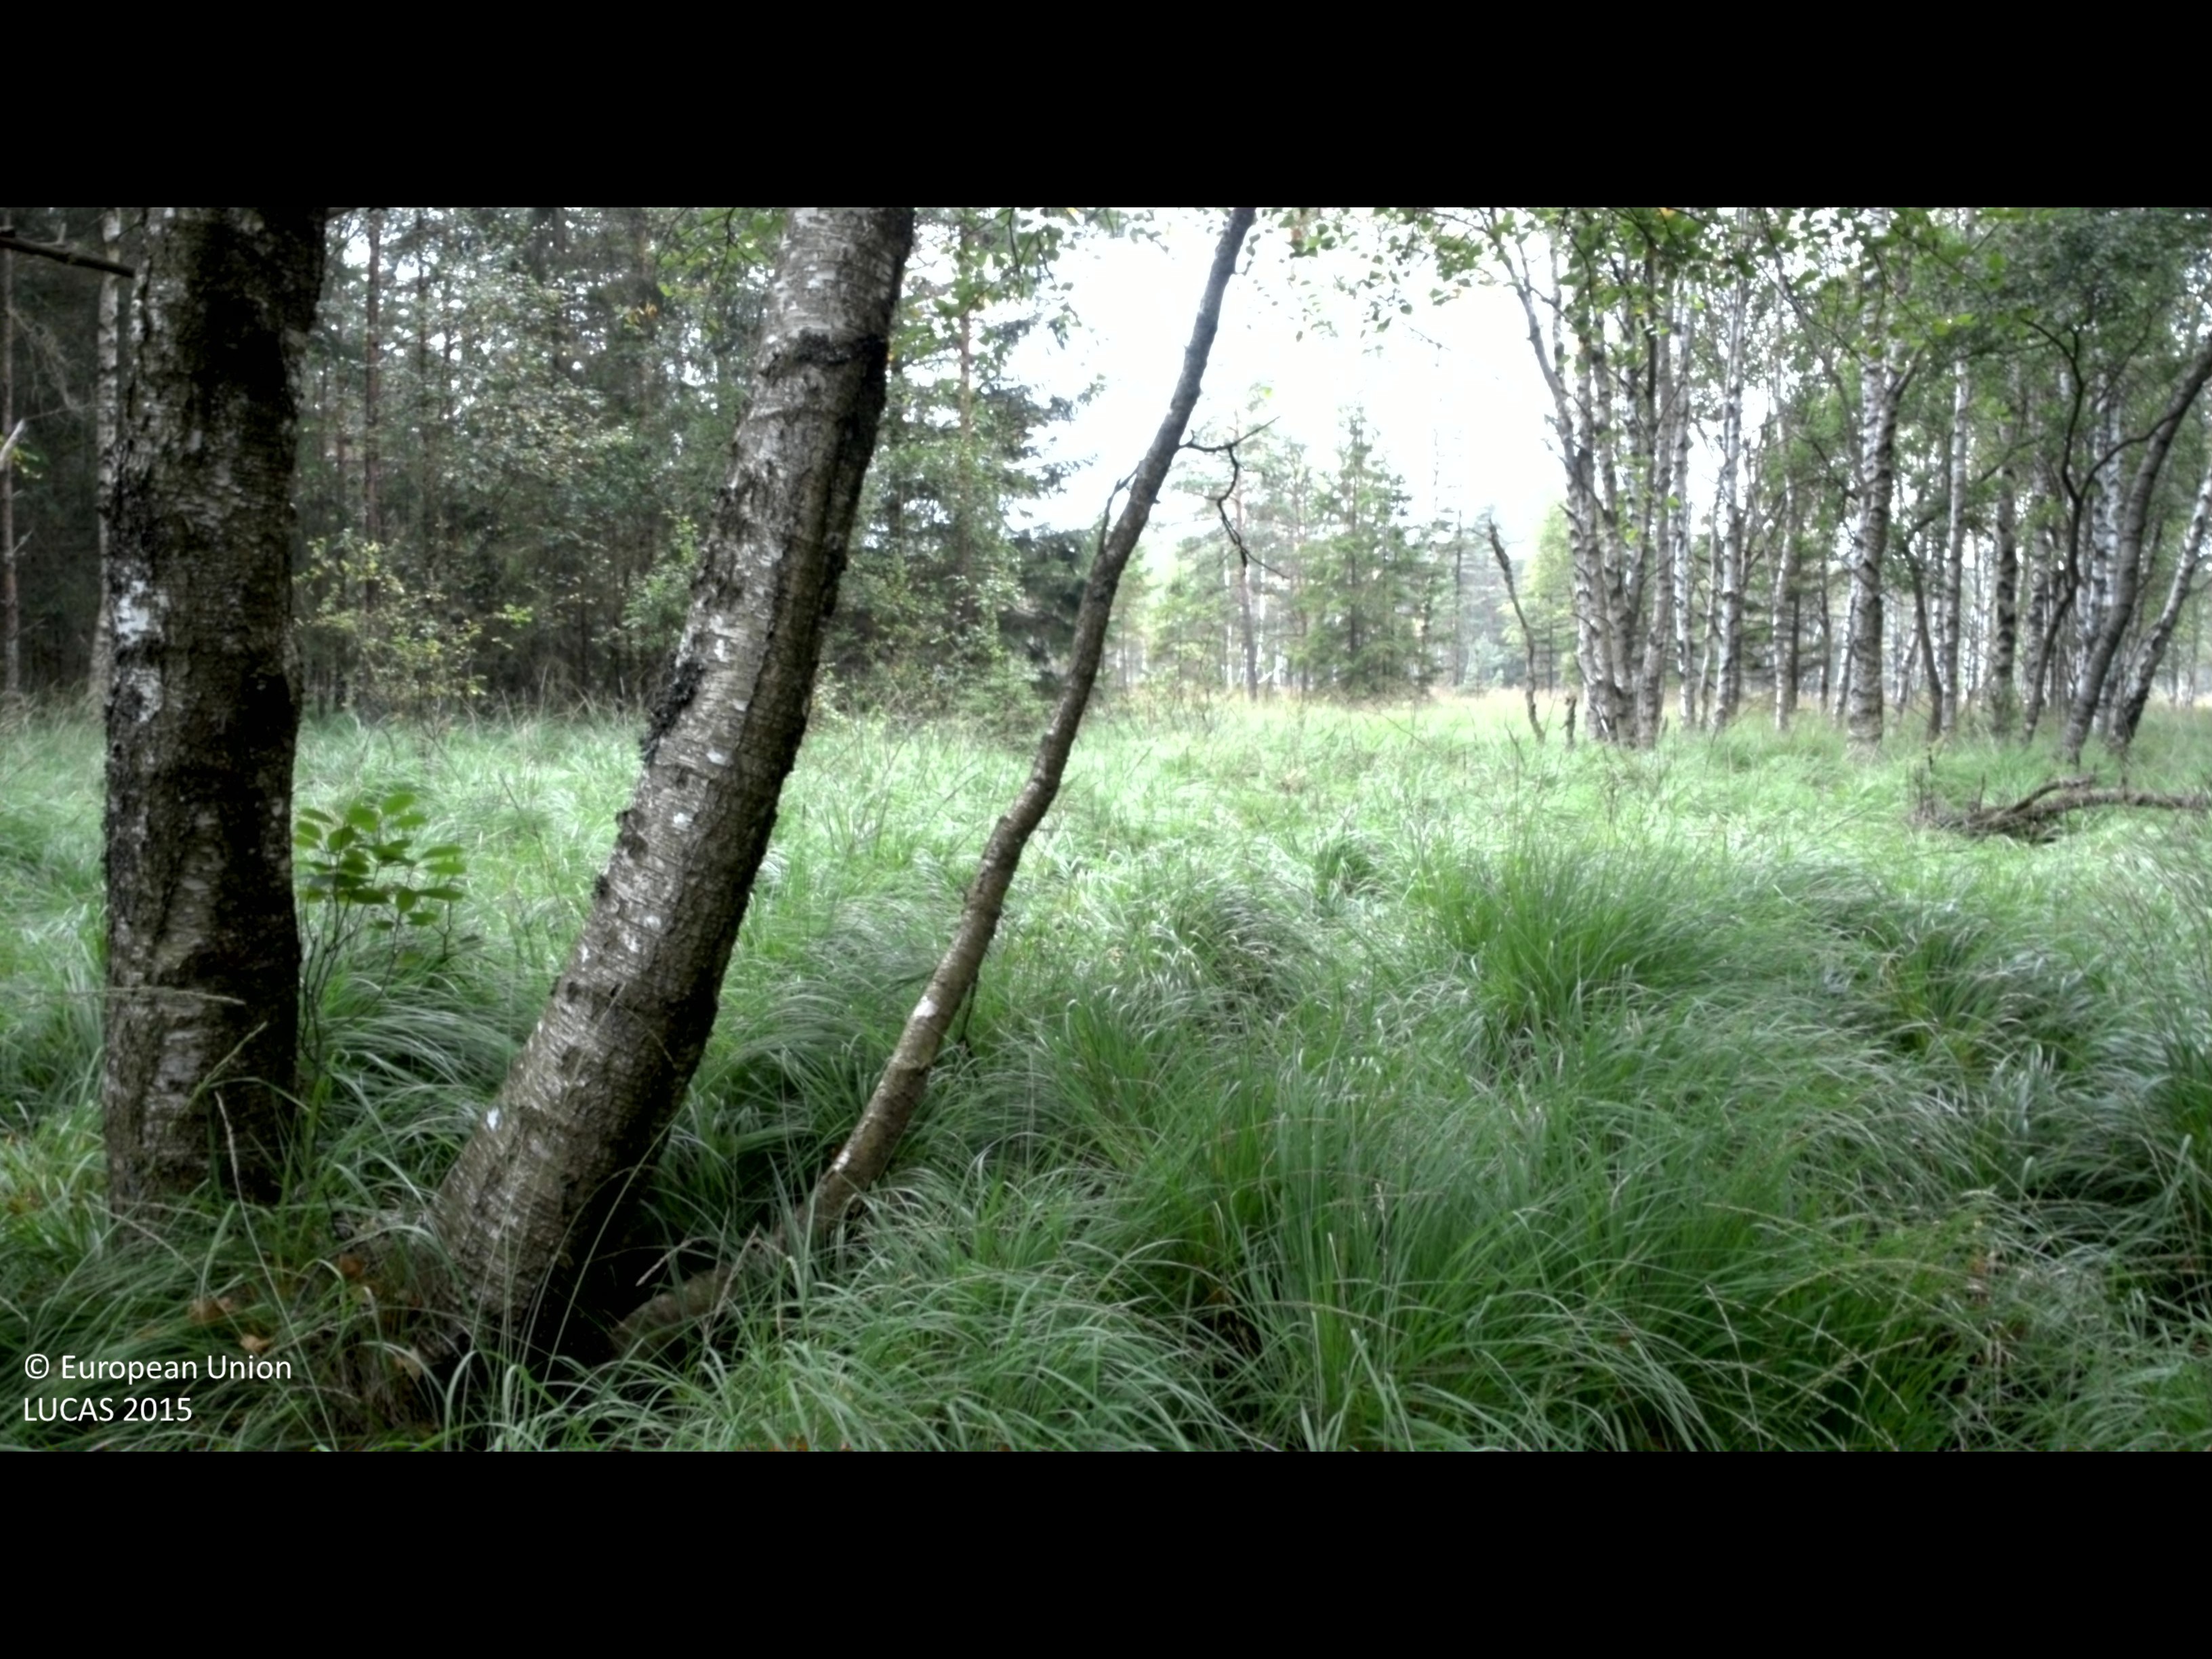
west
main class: Woodland
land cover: Broadleaved woodland
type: boreal forest
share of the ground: 25 - 50 %
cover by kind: herbaceous plants 55 %, broadleaved forest trees 40 %, shrubs 5 %
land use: Semi-natural and natural areas not in use
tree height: > 5 m
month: August
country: SE
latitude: 56.9232
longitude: 13.1344
